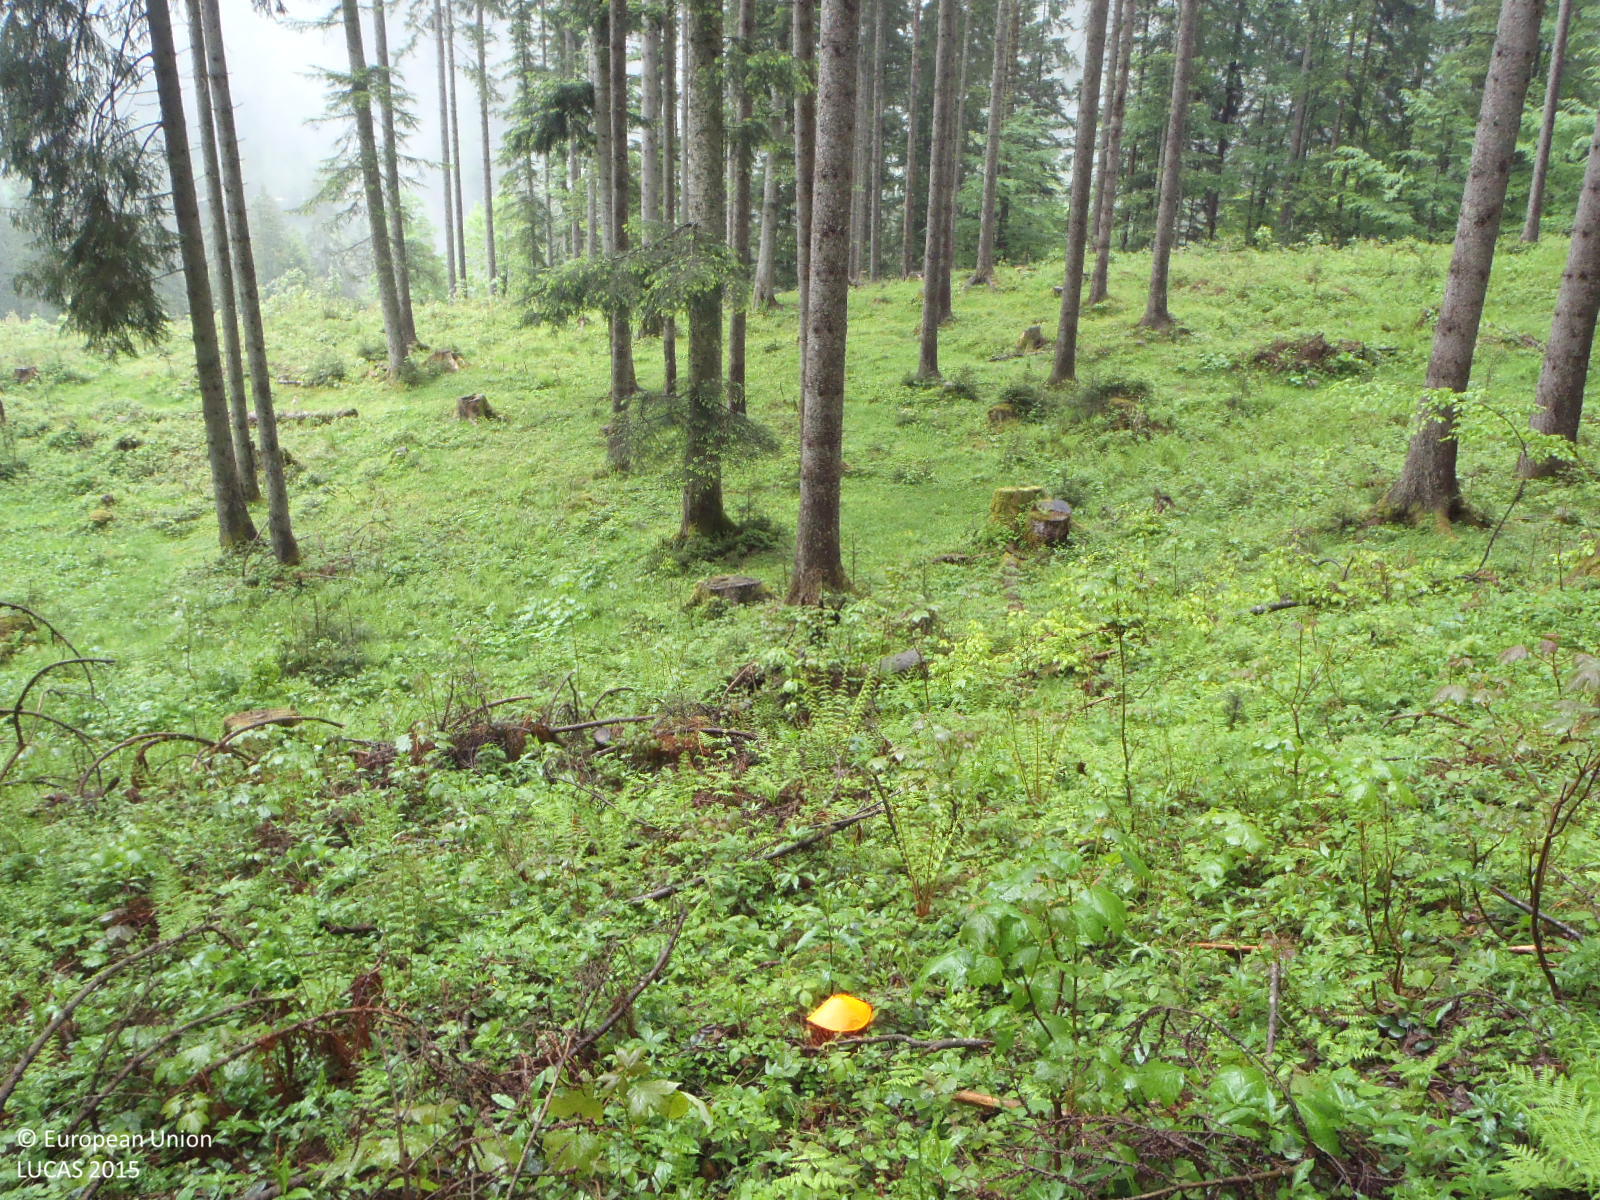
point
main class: Woodland
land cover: Other coniferous woodland
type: alpine coniferous forest
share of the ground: 50 - 75 %
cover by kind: coniferous forest trees 60 %, herbaceous plants 20 %, shrubs 10 %, lichens and mosses 10 %
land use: Forestry
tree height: > 5 m
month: May
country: AT
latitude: 47.5950
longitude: 12.7513
